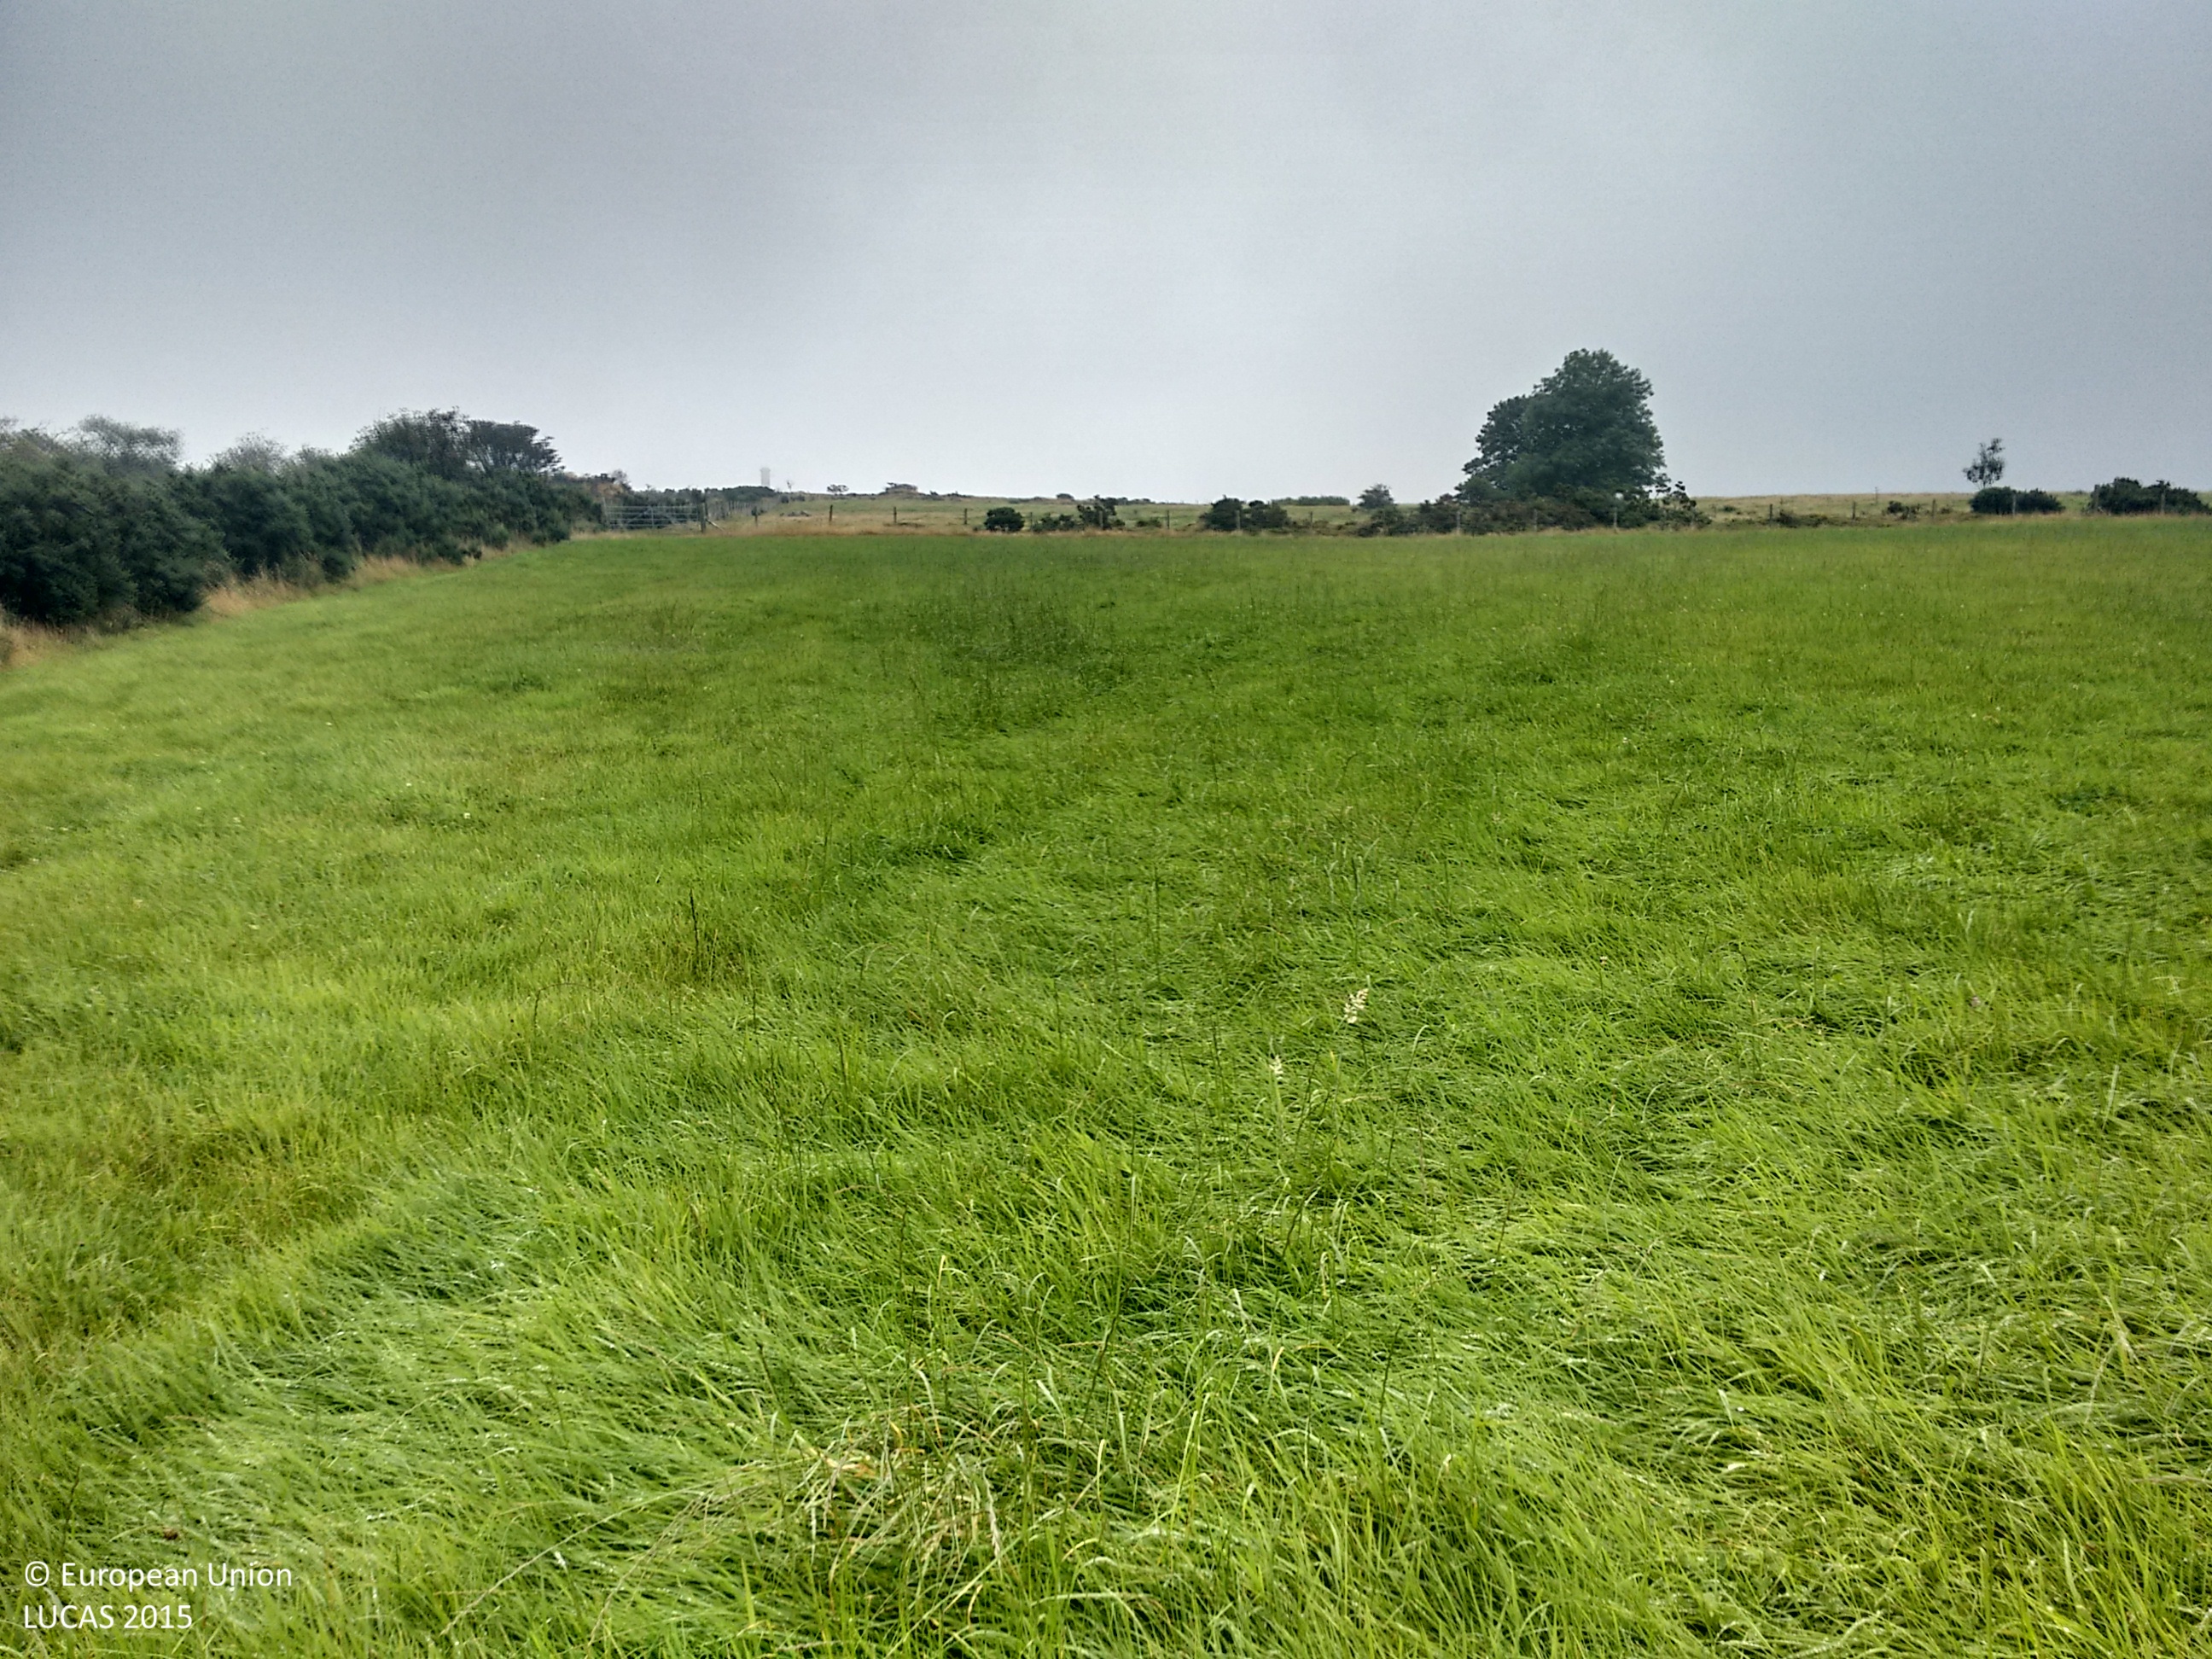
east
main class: Grassland
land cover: Grassland without tree/shrub cover
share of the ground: > 75 %
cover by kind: herbaceous plants 100 %
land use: Agriculture (excluding fallow land and kitchen gardens)
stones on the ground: < 10 %
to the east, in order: Grassland without tree/shrub cover; Fences; Grassland without tree/shrub cover; Single bushes/trees; Grassland without tree/shrub cover
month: August
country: GB
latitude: 50.5187
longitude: -4.3027
